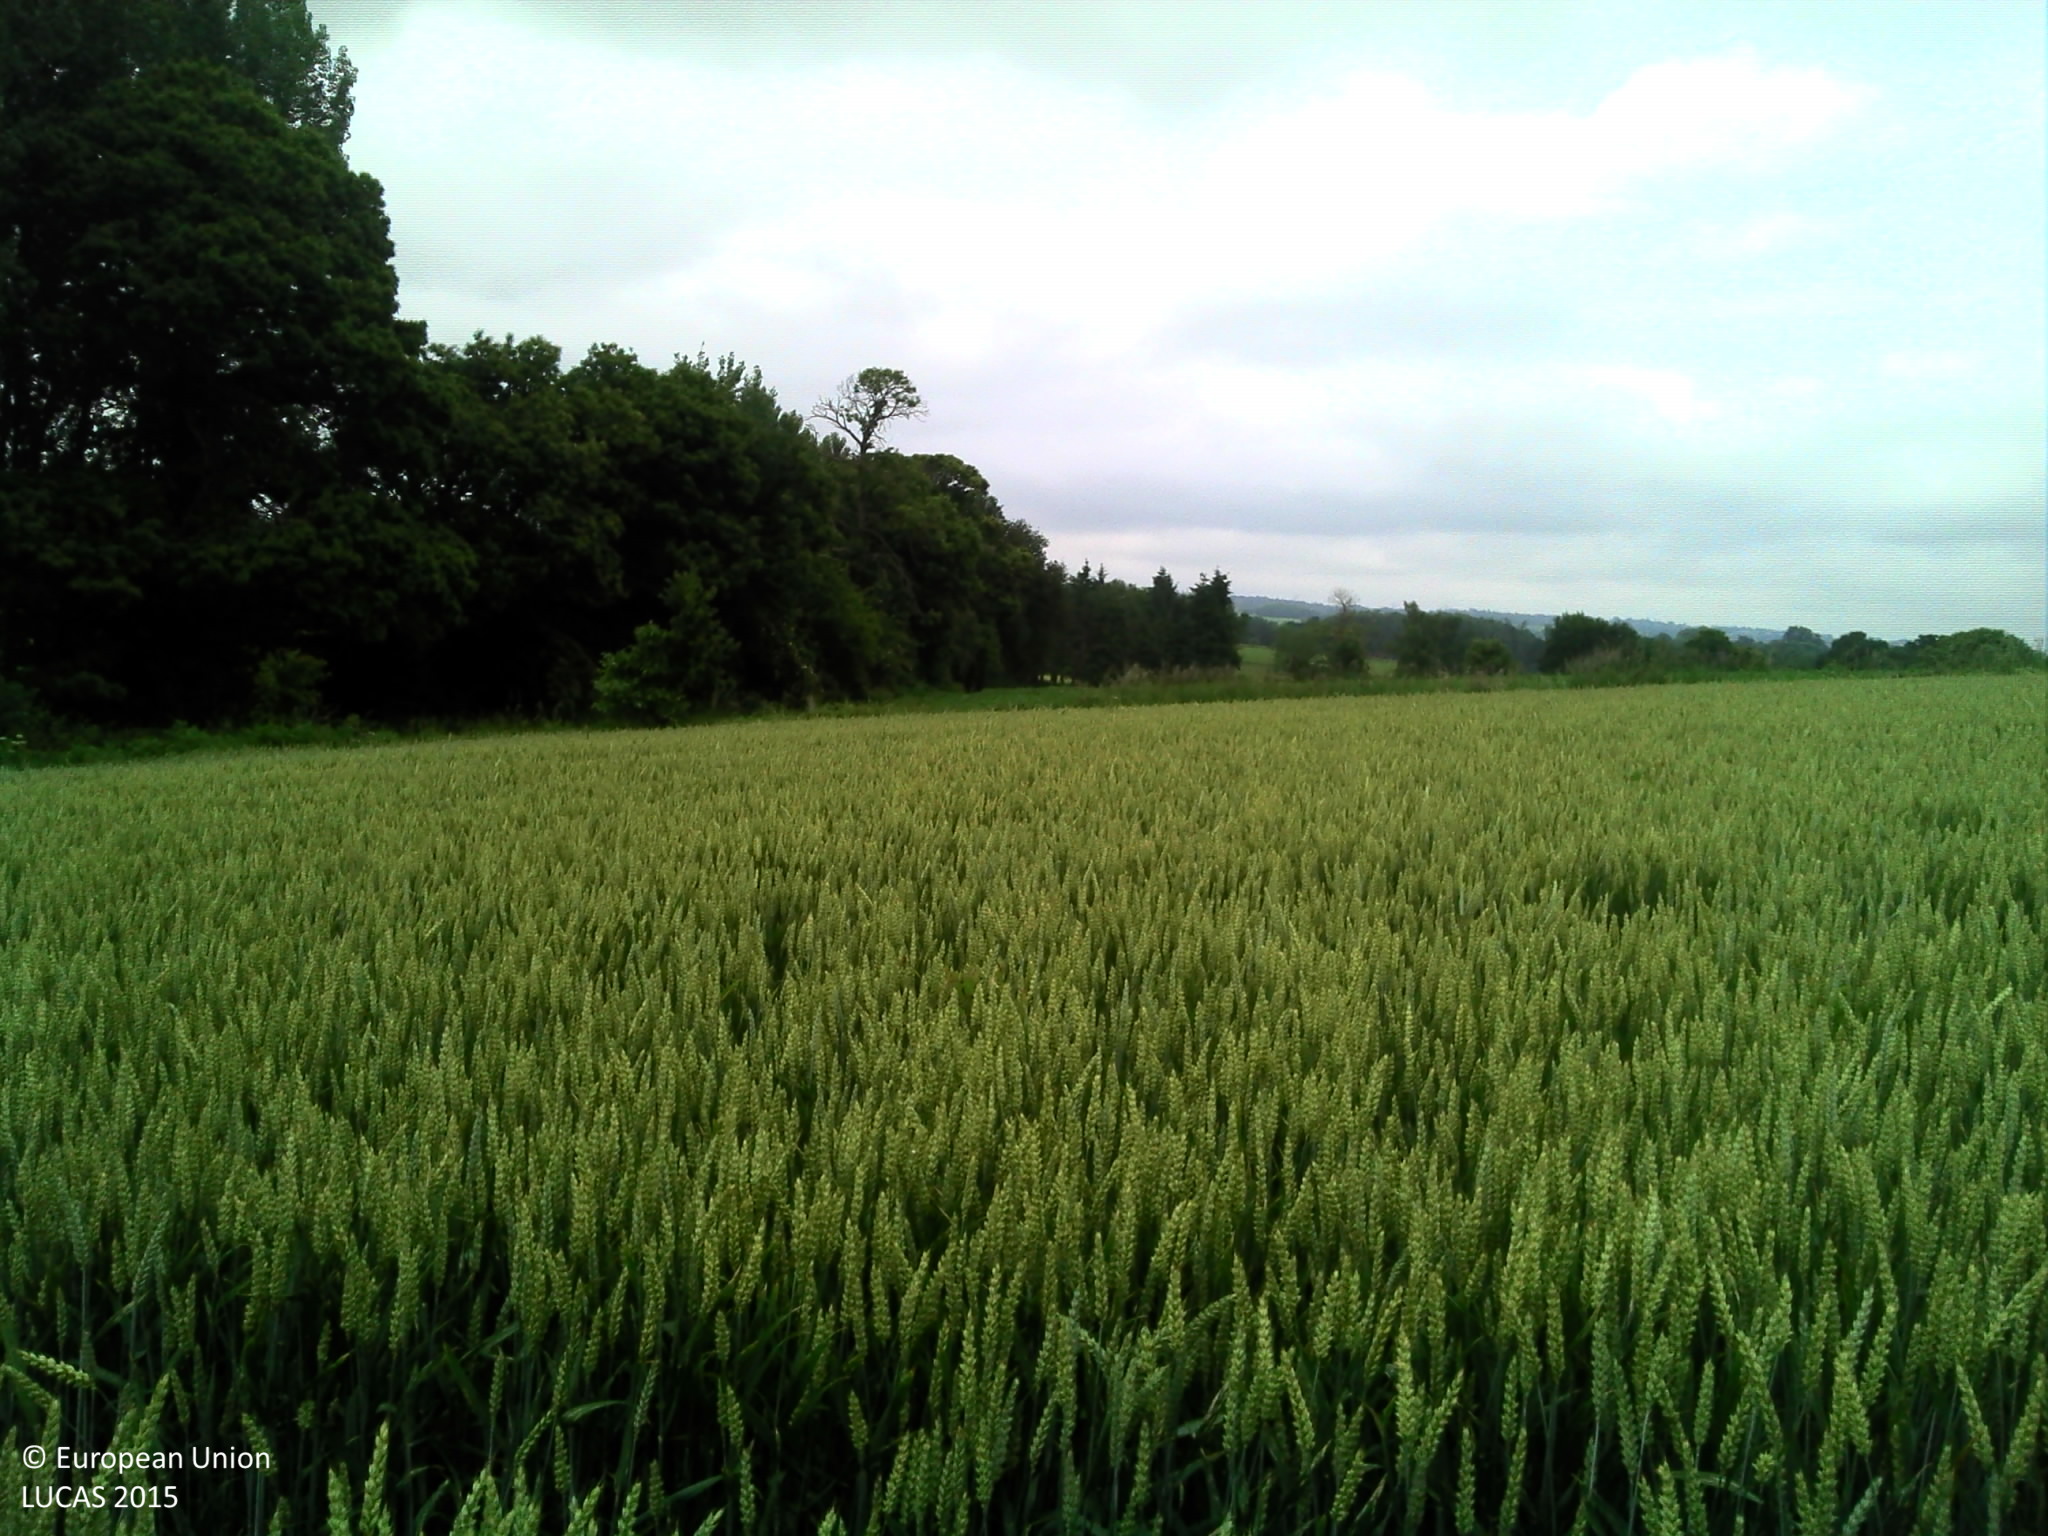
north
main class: Cropland
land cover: Common wheat
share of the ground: > 75 %
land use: Agriculture (excluding fallow land and kitchen gardens)
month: June
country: FR
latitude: 48.3001
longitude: -1.2456
